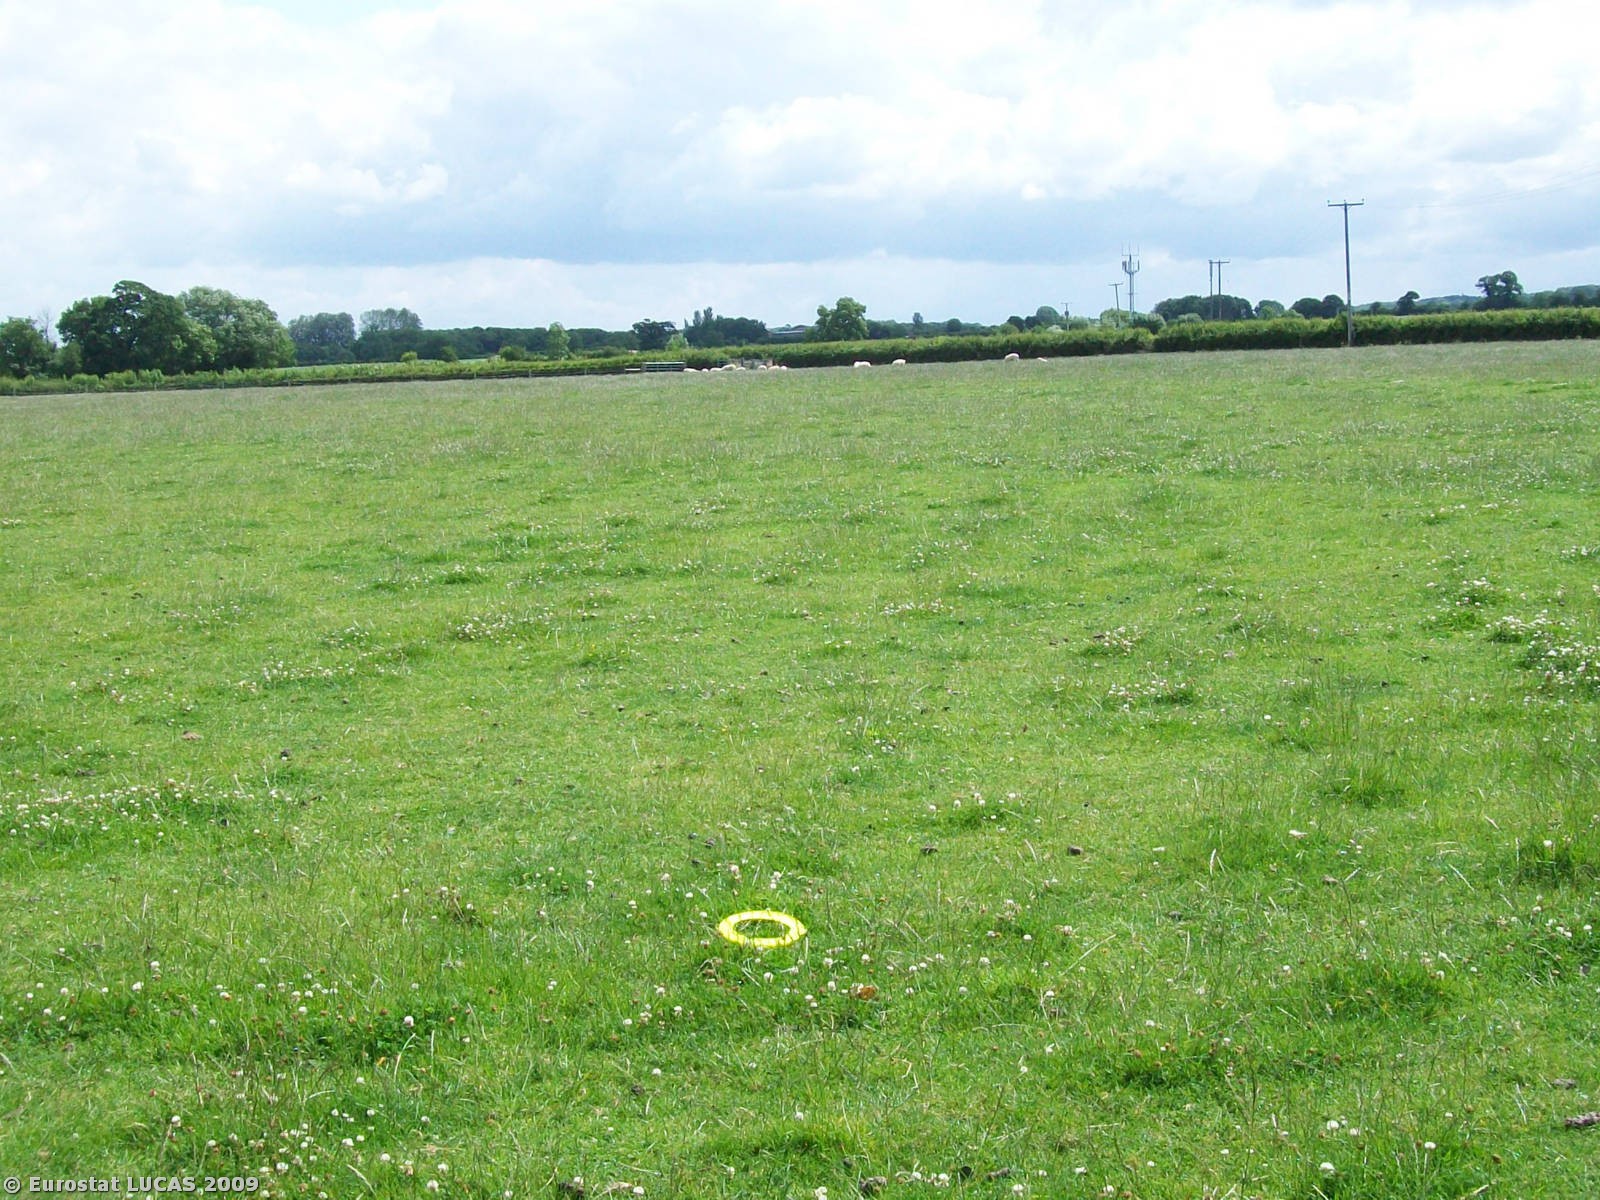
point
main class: Grassland
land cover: Grassland without tree/shrub cover
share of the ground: > 75 %
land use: Agriculture (excluding fallow land and kitchen gardens)
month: July
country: GB
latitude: 51.1195
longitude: -2.7717
